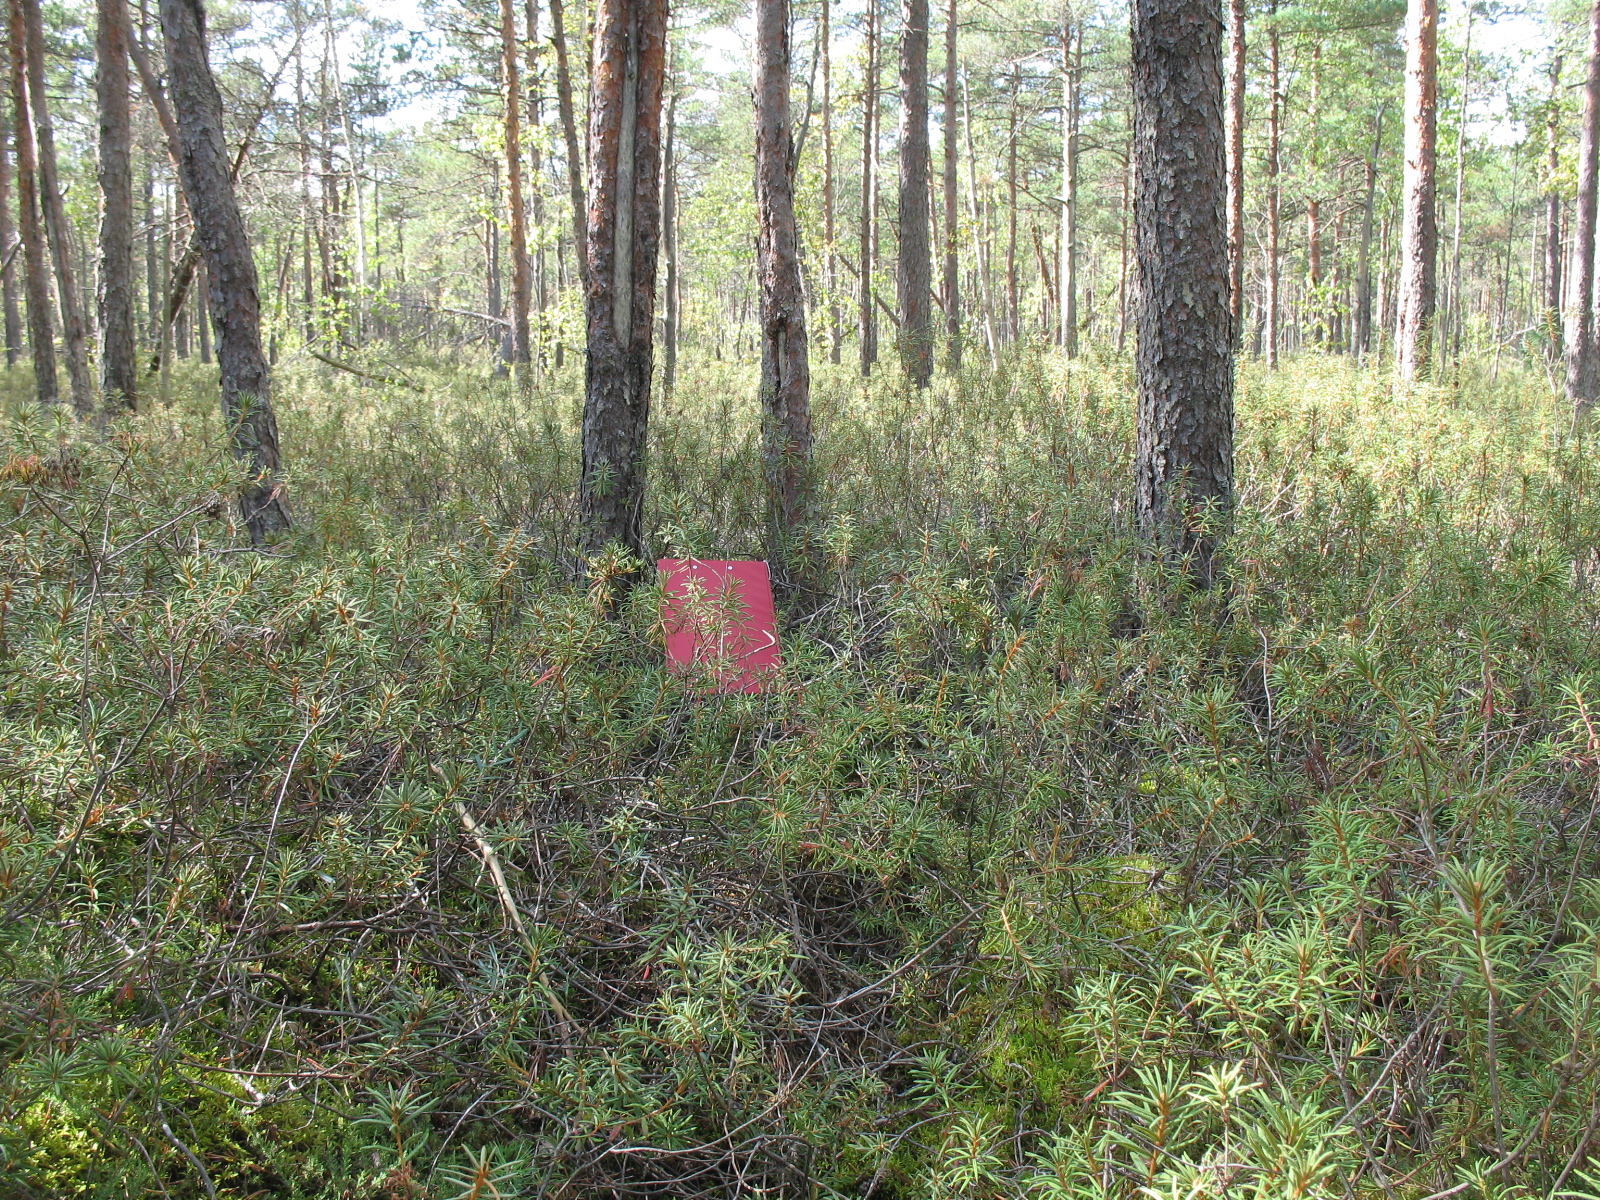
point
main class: Woodland
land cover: Pine dominated coniferous woodland
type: hemiboreal forest and nemoral coniferous forest and mixed broadleaved-coniferous forest
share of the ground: 25 - 50 %
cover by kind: coniferous forest trees 40 %, lichens and mosses 30 %, herbaceous plants 15 %, shrubs 10 %, broadleaved forest trees 5 %
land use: Forestry
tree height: > 5 m
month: September
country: LV
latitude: 56.1631
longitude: 25.4337
